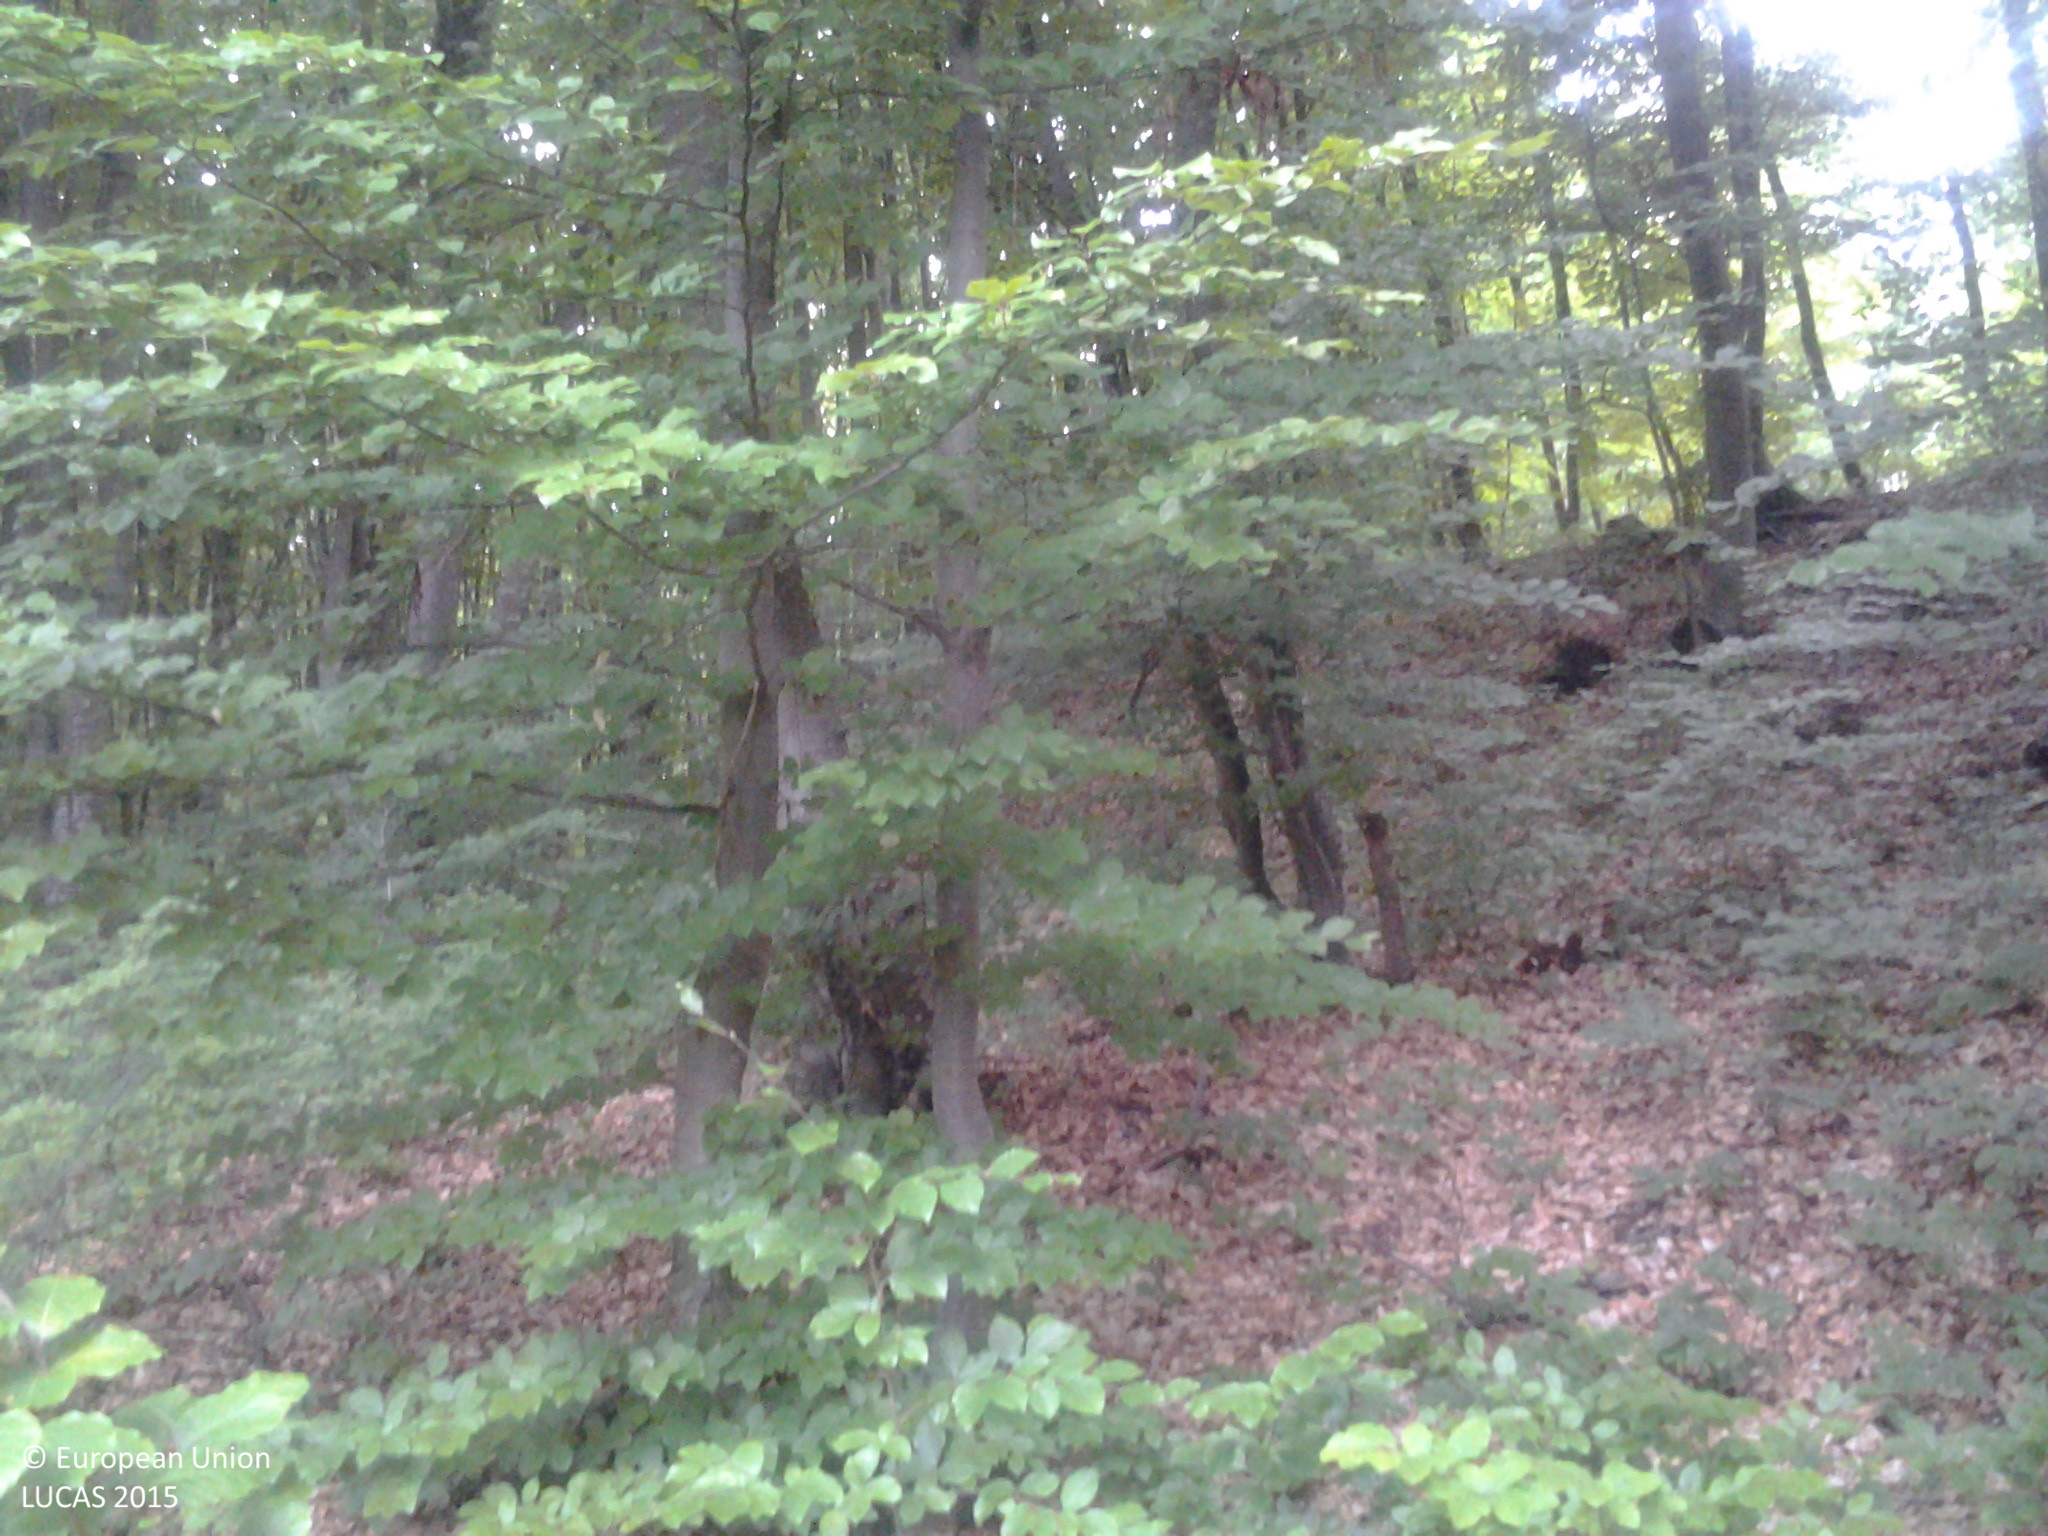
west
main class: Woodland
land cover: Broadleaved woodland
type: beech forest
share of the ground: > 75 %
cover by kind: broadleaved forest trees 100 %
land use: Forestry
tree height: > 5 m
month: June
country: RO
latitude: 46.6235
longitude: 27.1710
